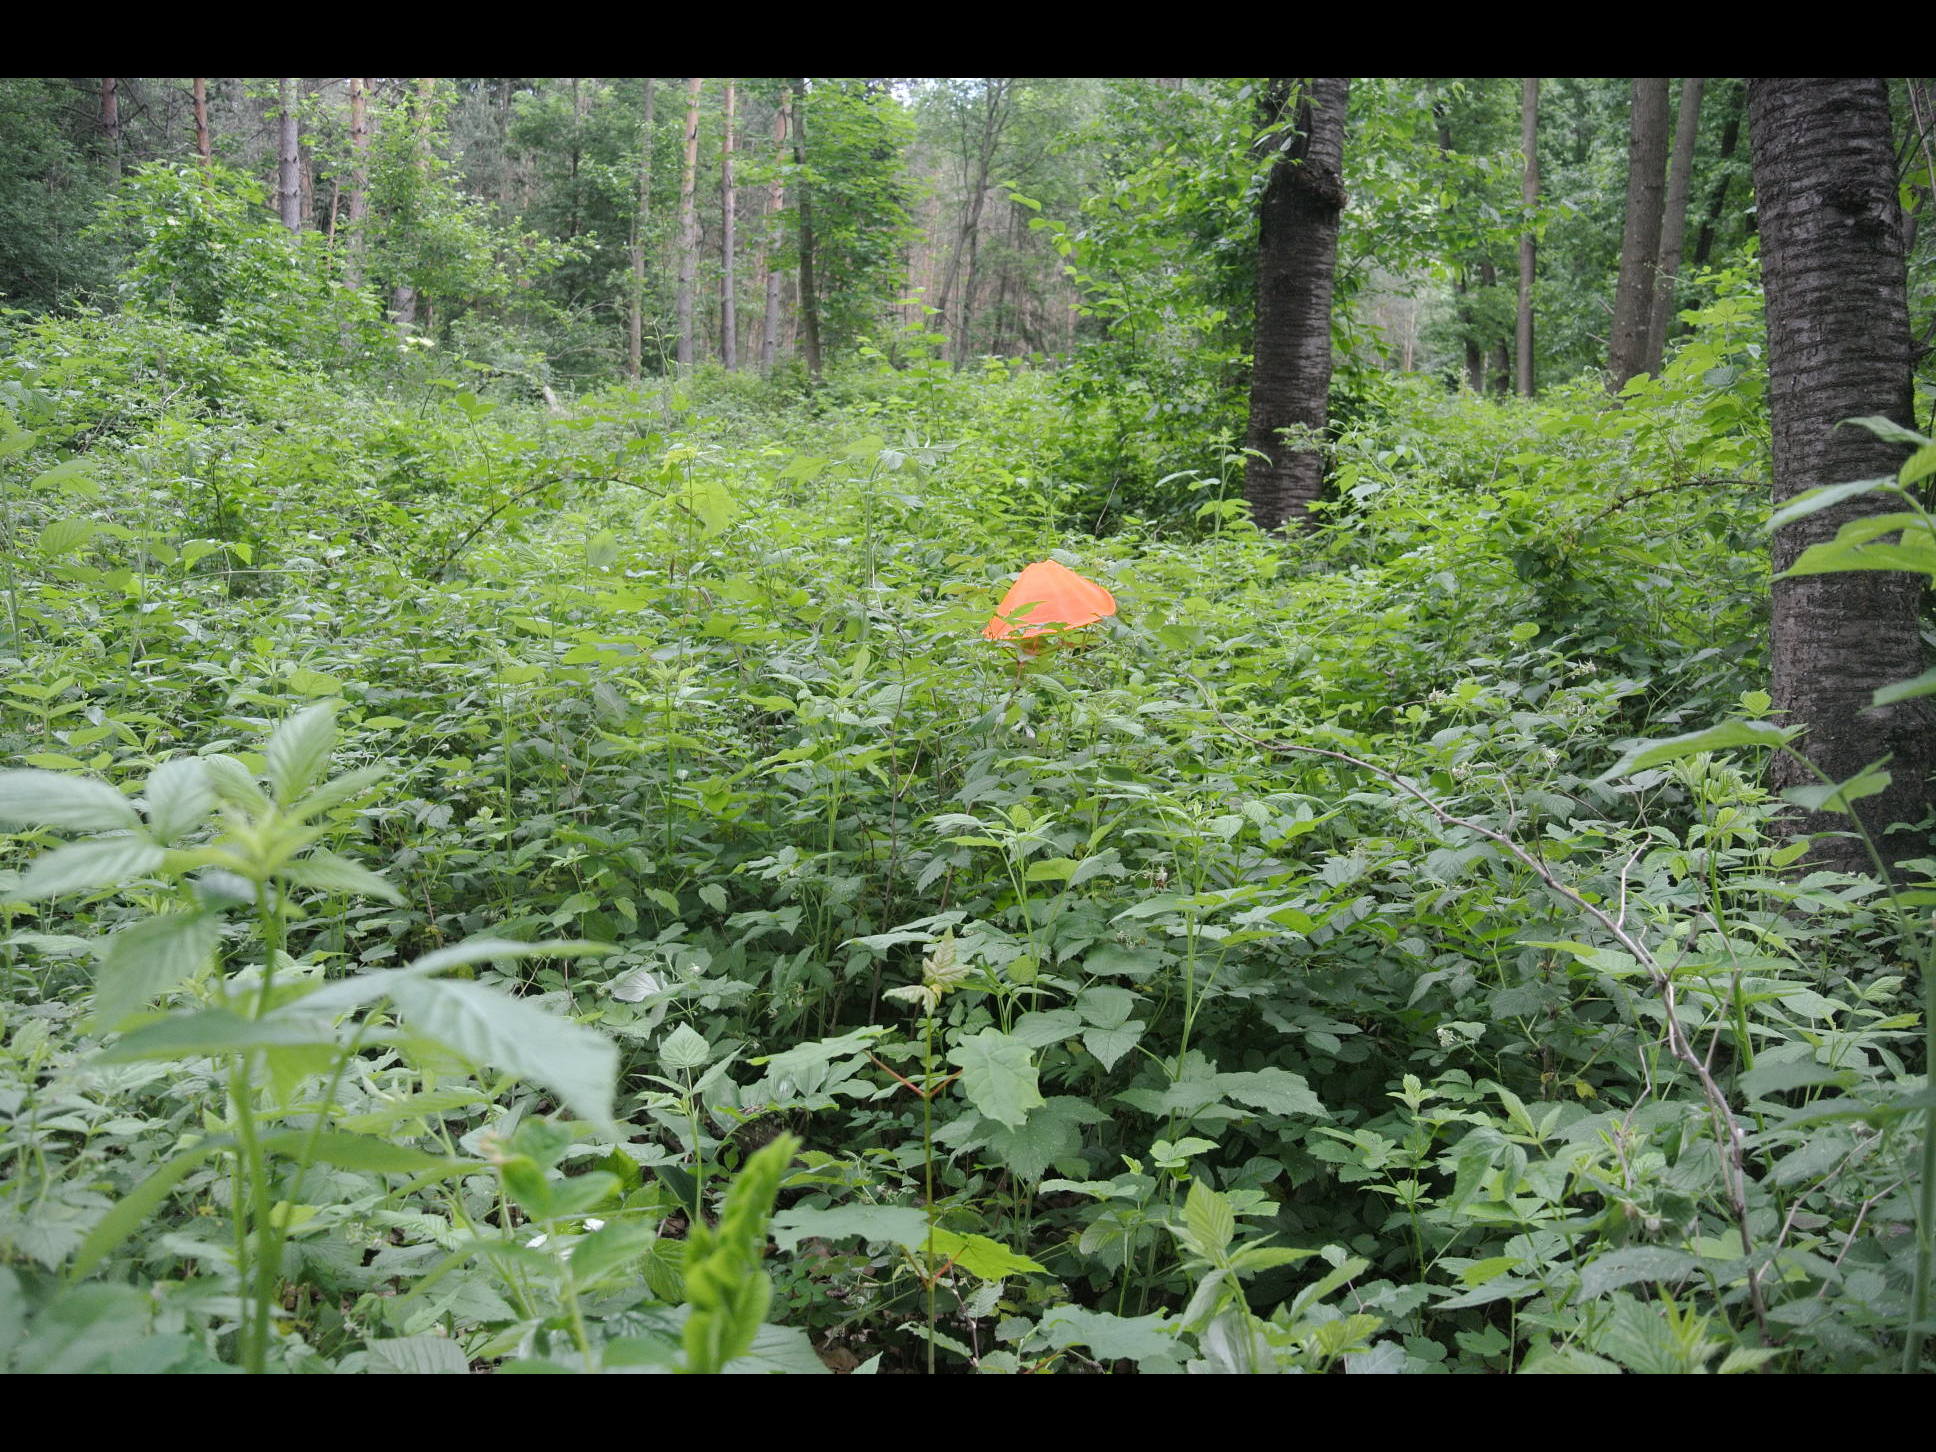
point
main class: Woodland
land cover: Broadleaved woodland
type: beech forest
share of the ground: > 75 %
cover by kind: broadleaved forest trees 80 %, shrubs 10 %, herbaceous plants 10 %
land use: Forestry
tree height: > 5 m
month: June
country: AT
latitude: 48.0527
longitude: 16.1351
